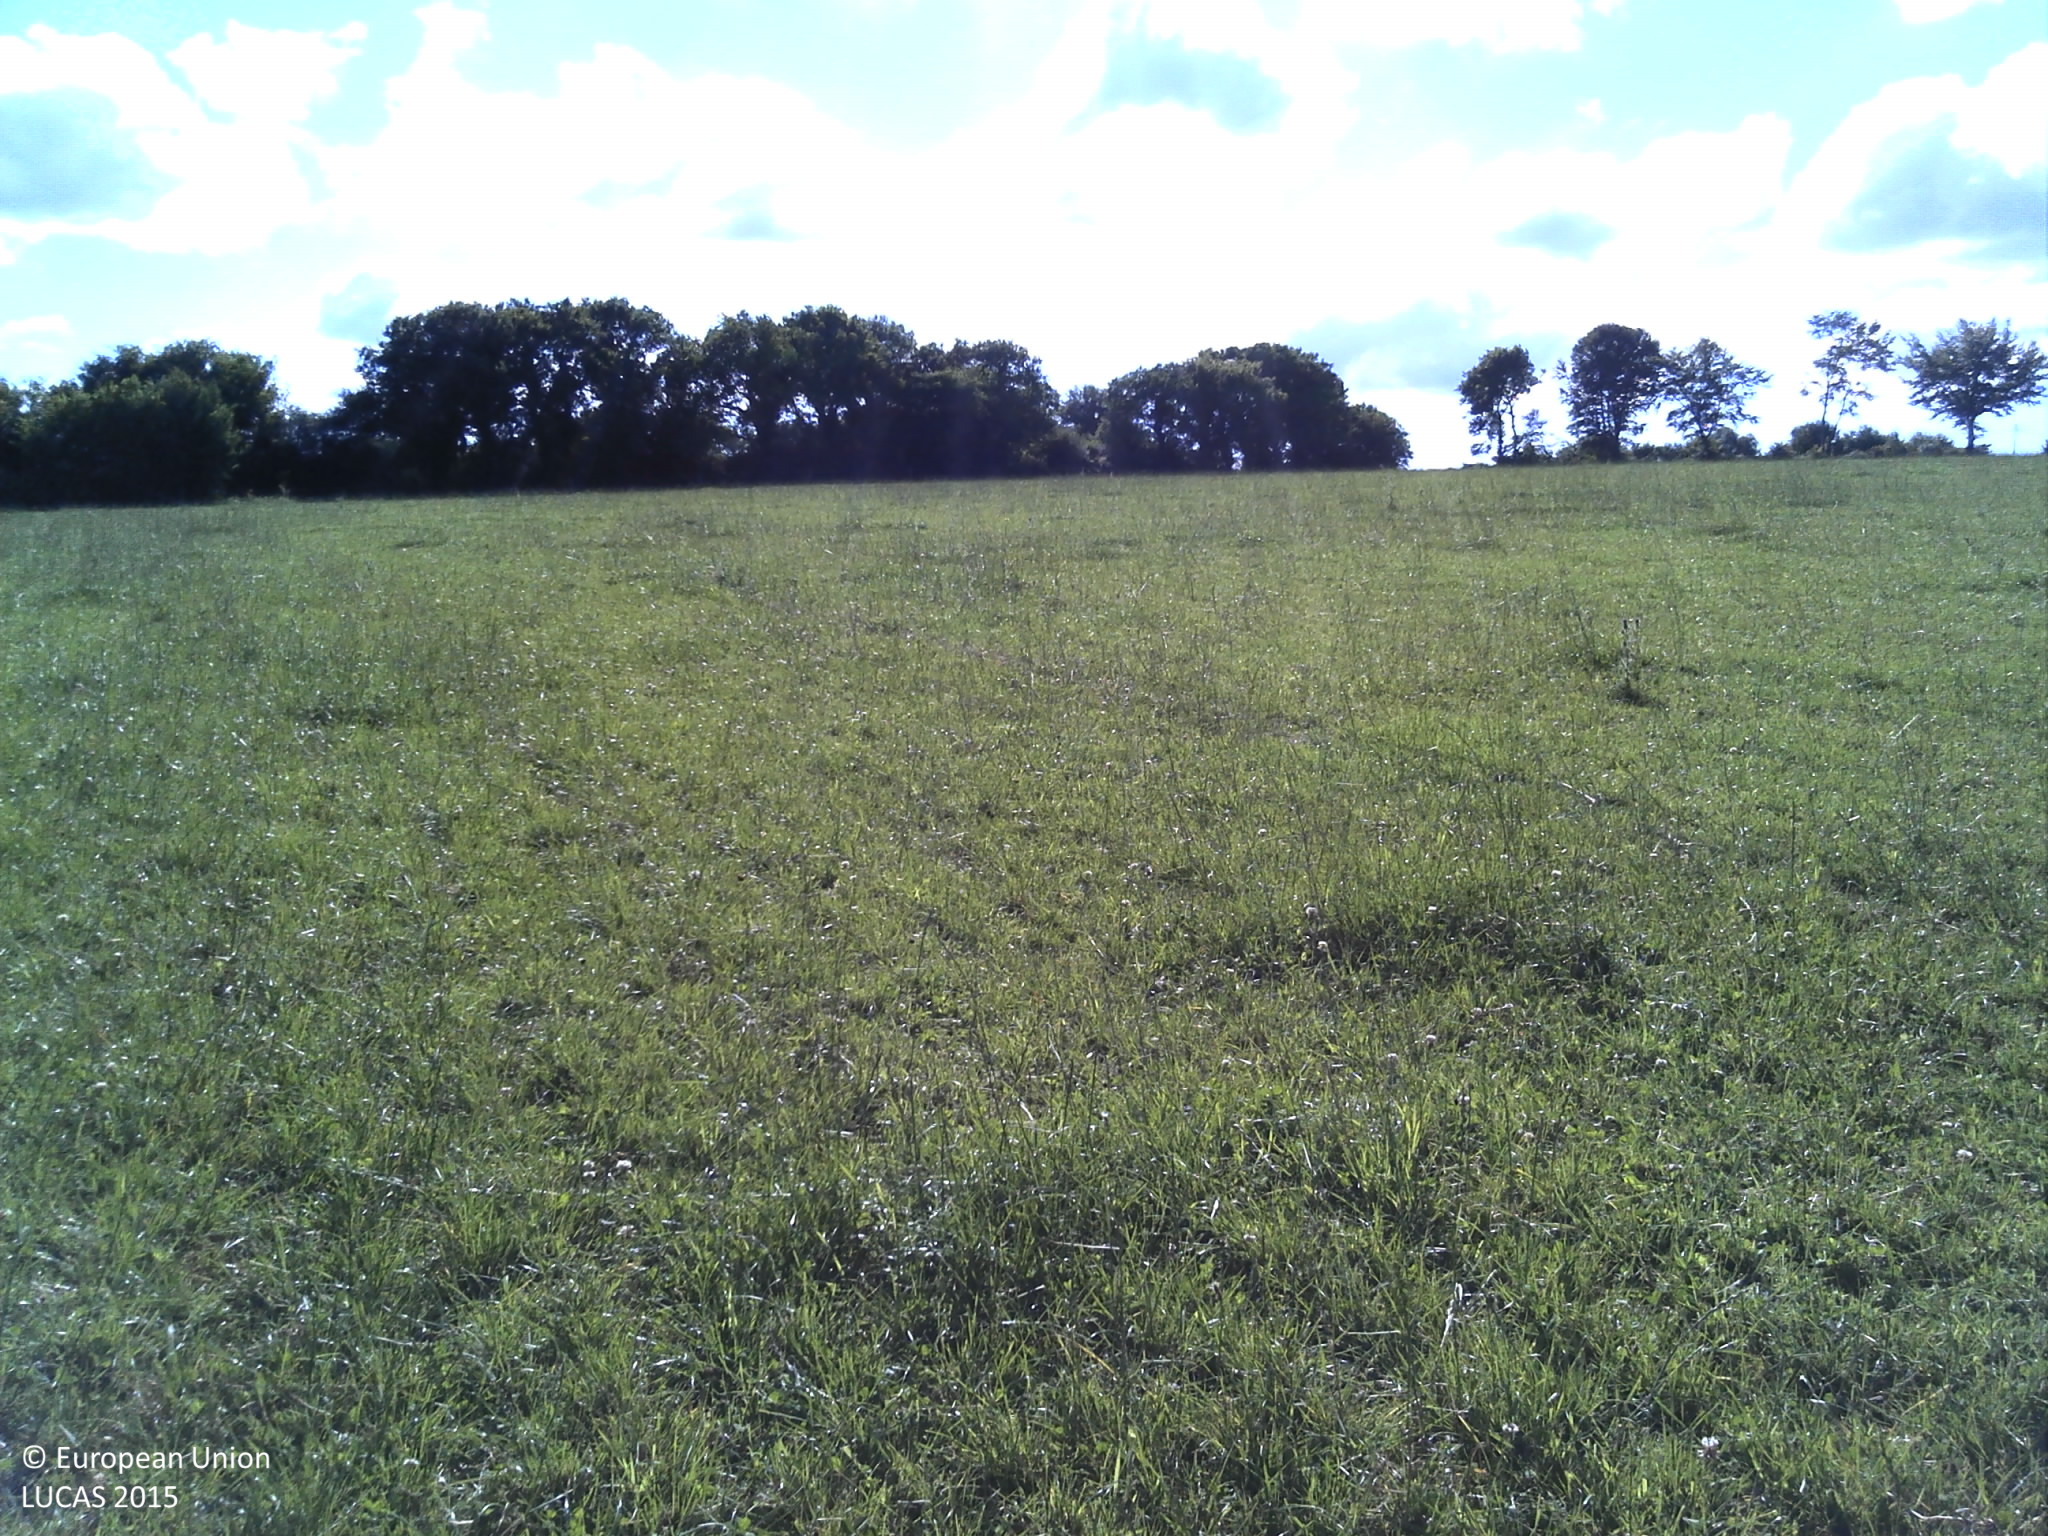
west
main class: Grassland
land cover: Grassland without tree/shrub cover
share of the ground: > 75 %
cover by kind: herbaceous plants 100 %
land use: Agriculture (excluding fallow land and kitchen gardens)
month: July
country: FR
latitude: 48.4724
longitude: -3.7314
